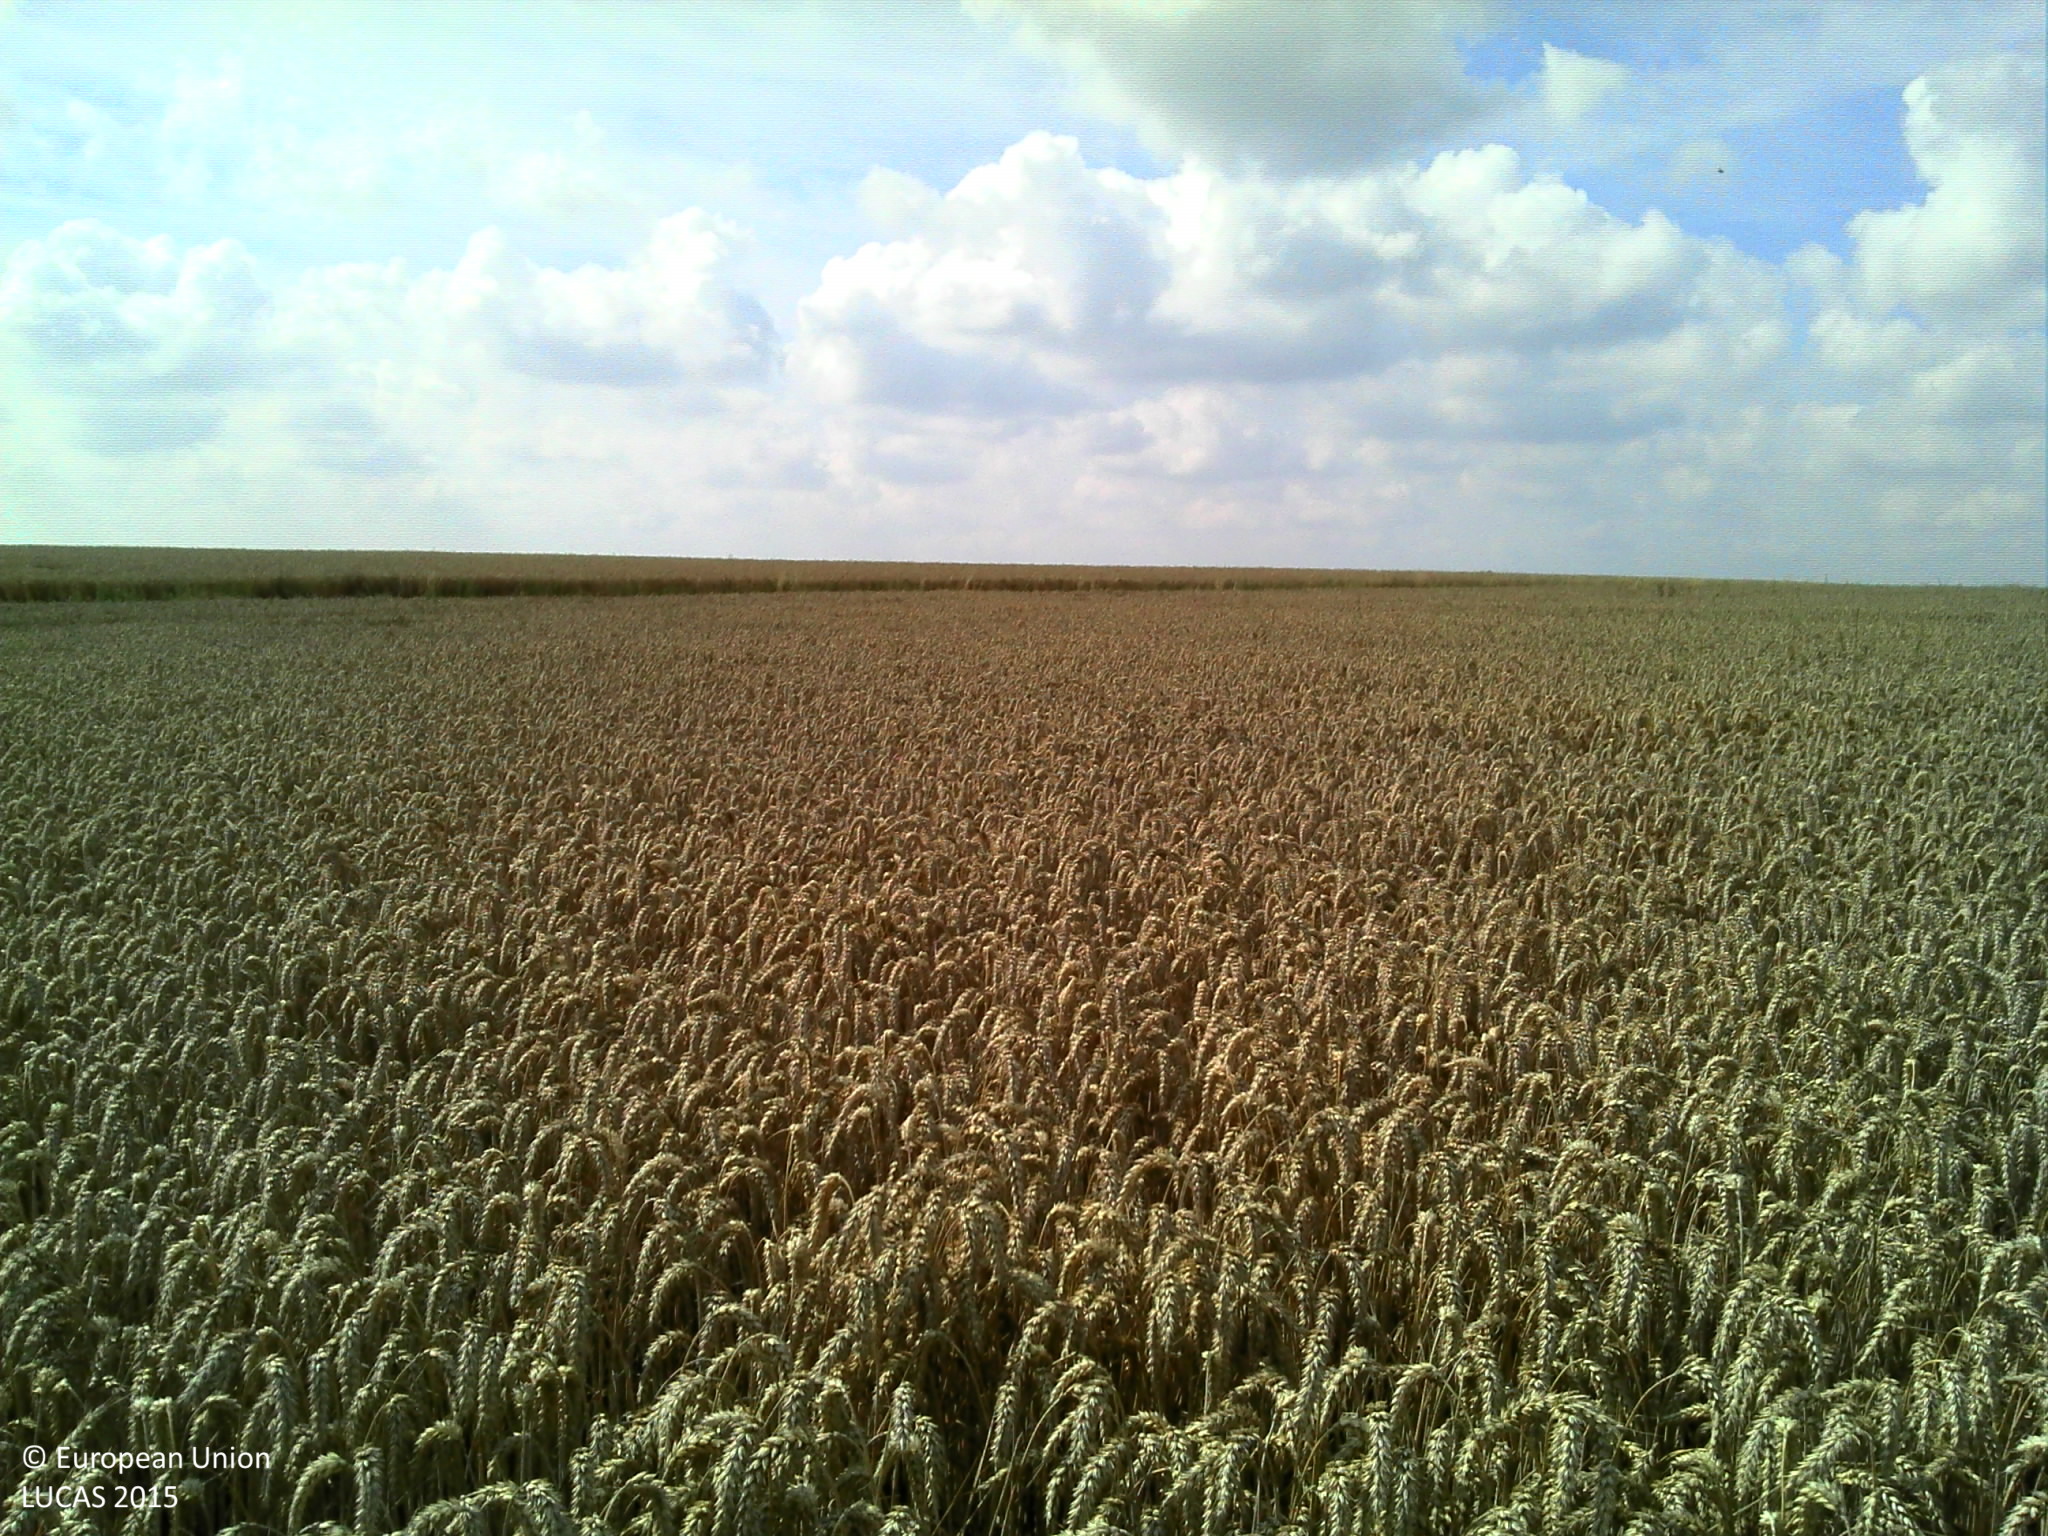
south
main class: Cropland
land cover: Common wheat
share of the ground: > 75 %
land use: Agriculture (excluding fallow land and kitchen gardens)
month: July
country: FR
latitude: 50.1001
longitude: 2.5081
